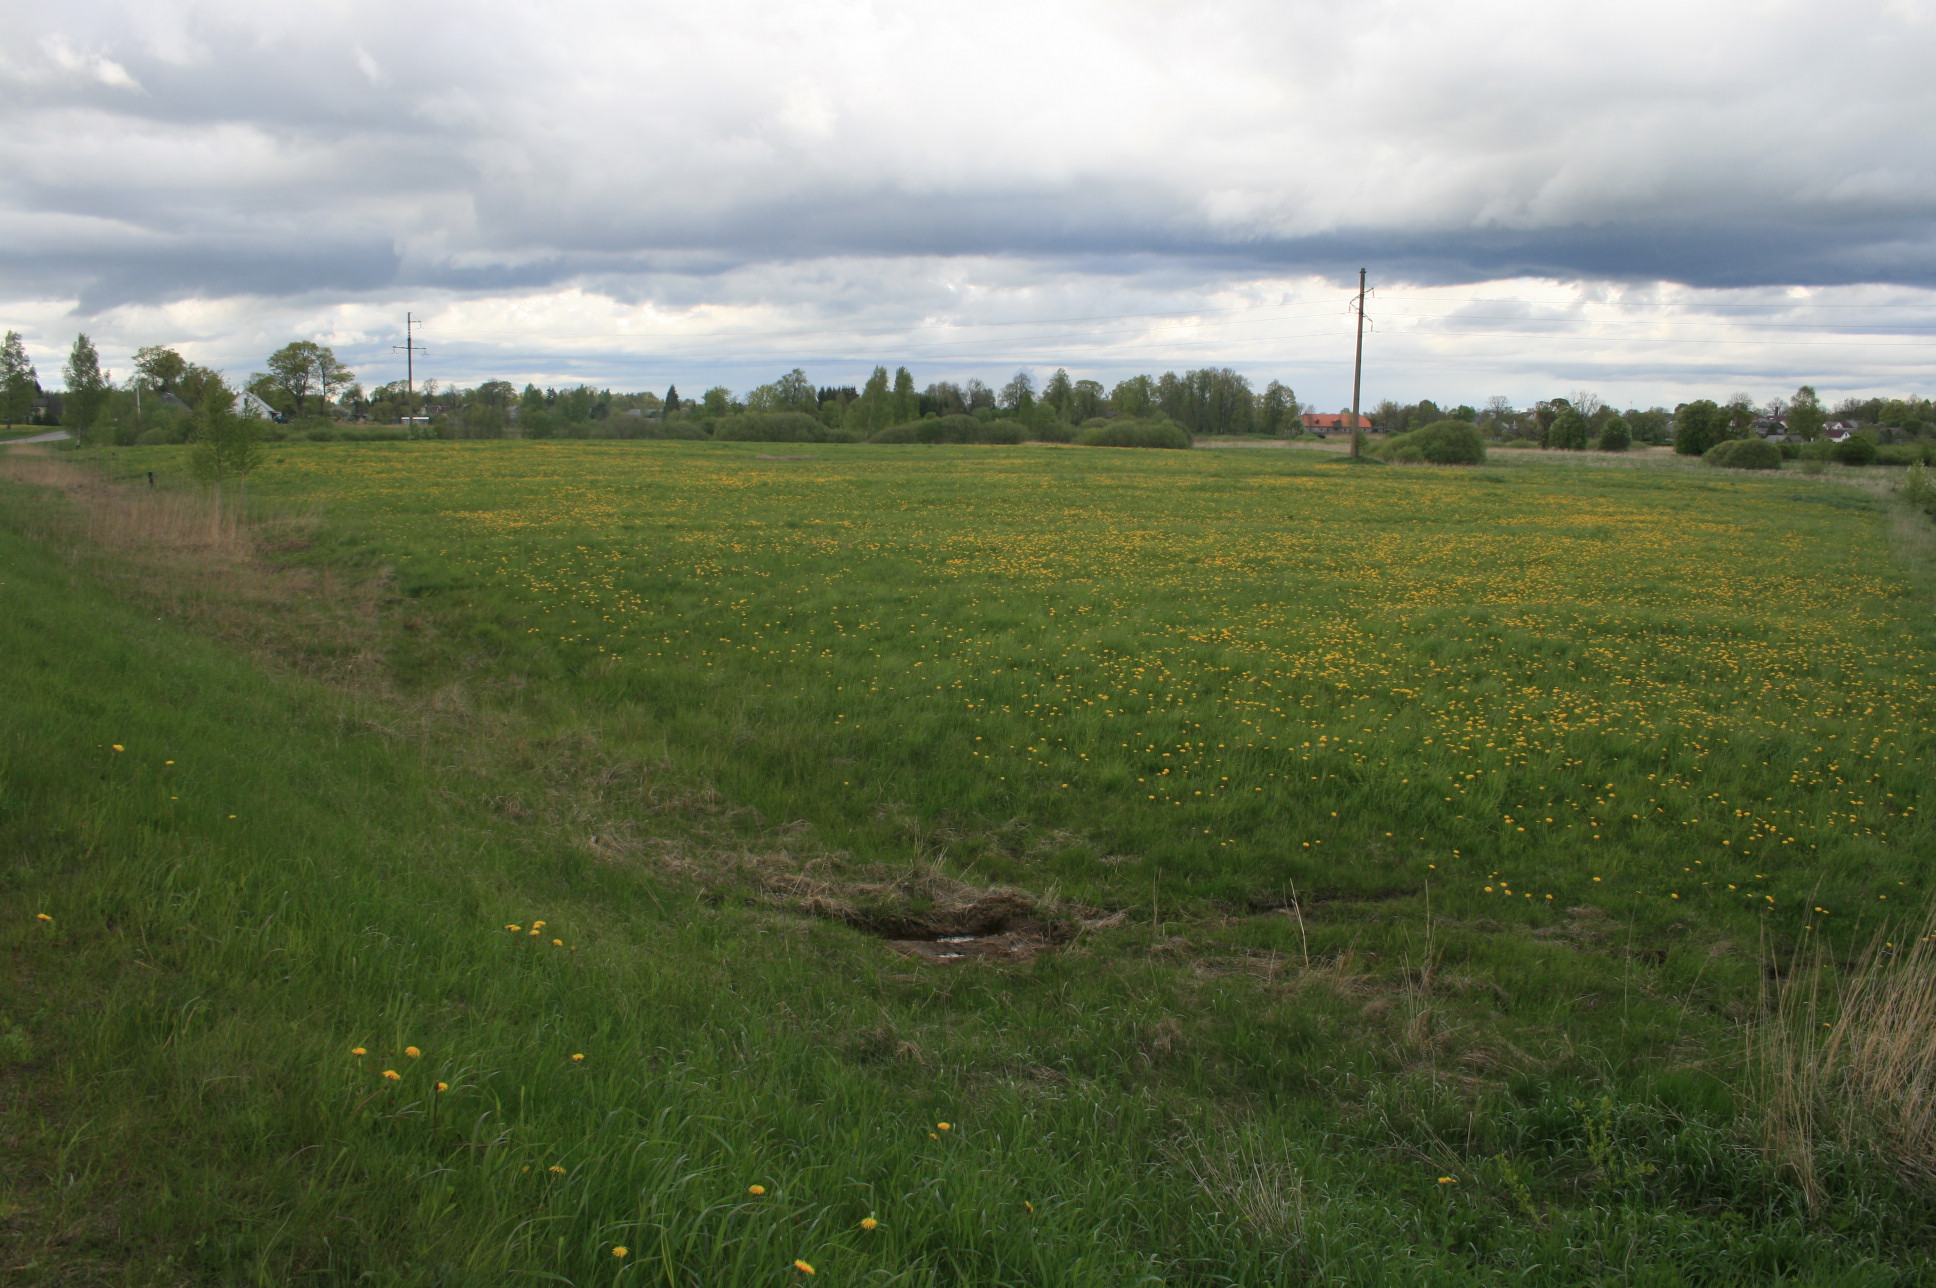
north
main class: Grassland
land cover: Grassland without tree/shrub cover
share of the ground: > 75 %
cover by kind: herbaceous plants 100 %
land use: Agriculture (excluding fallow land and kitchen gardens)
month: May
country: LT
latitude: 56.1606
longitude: 22.0799
